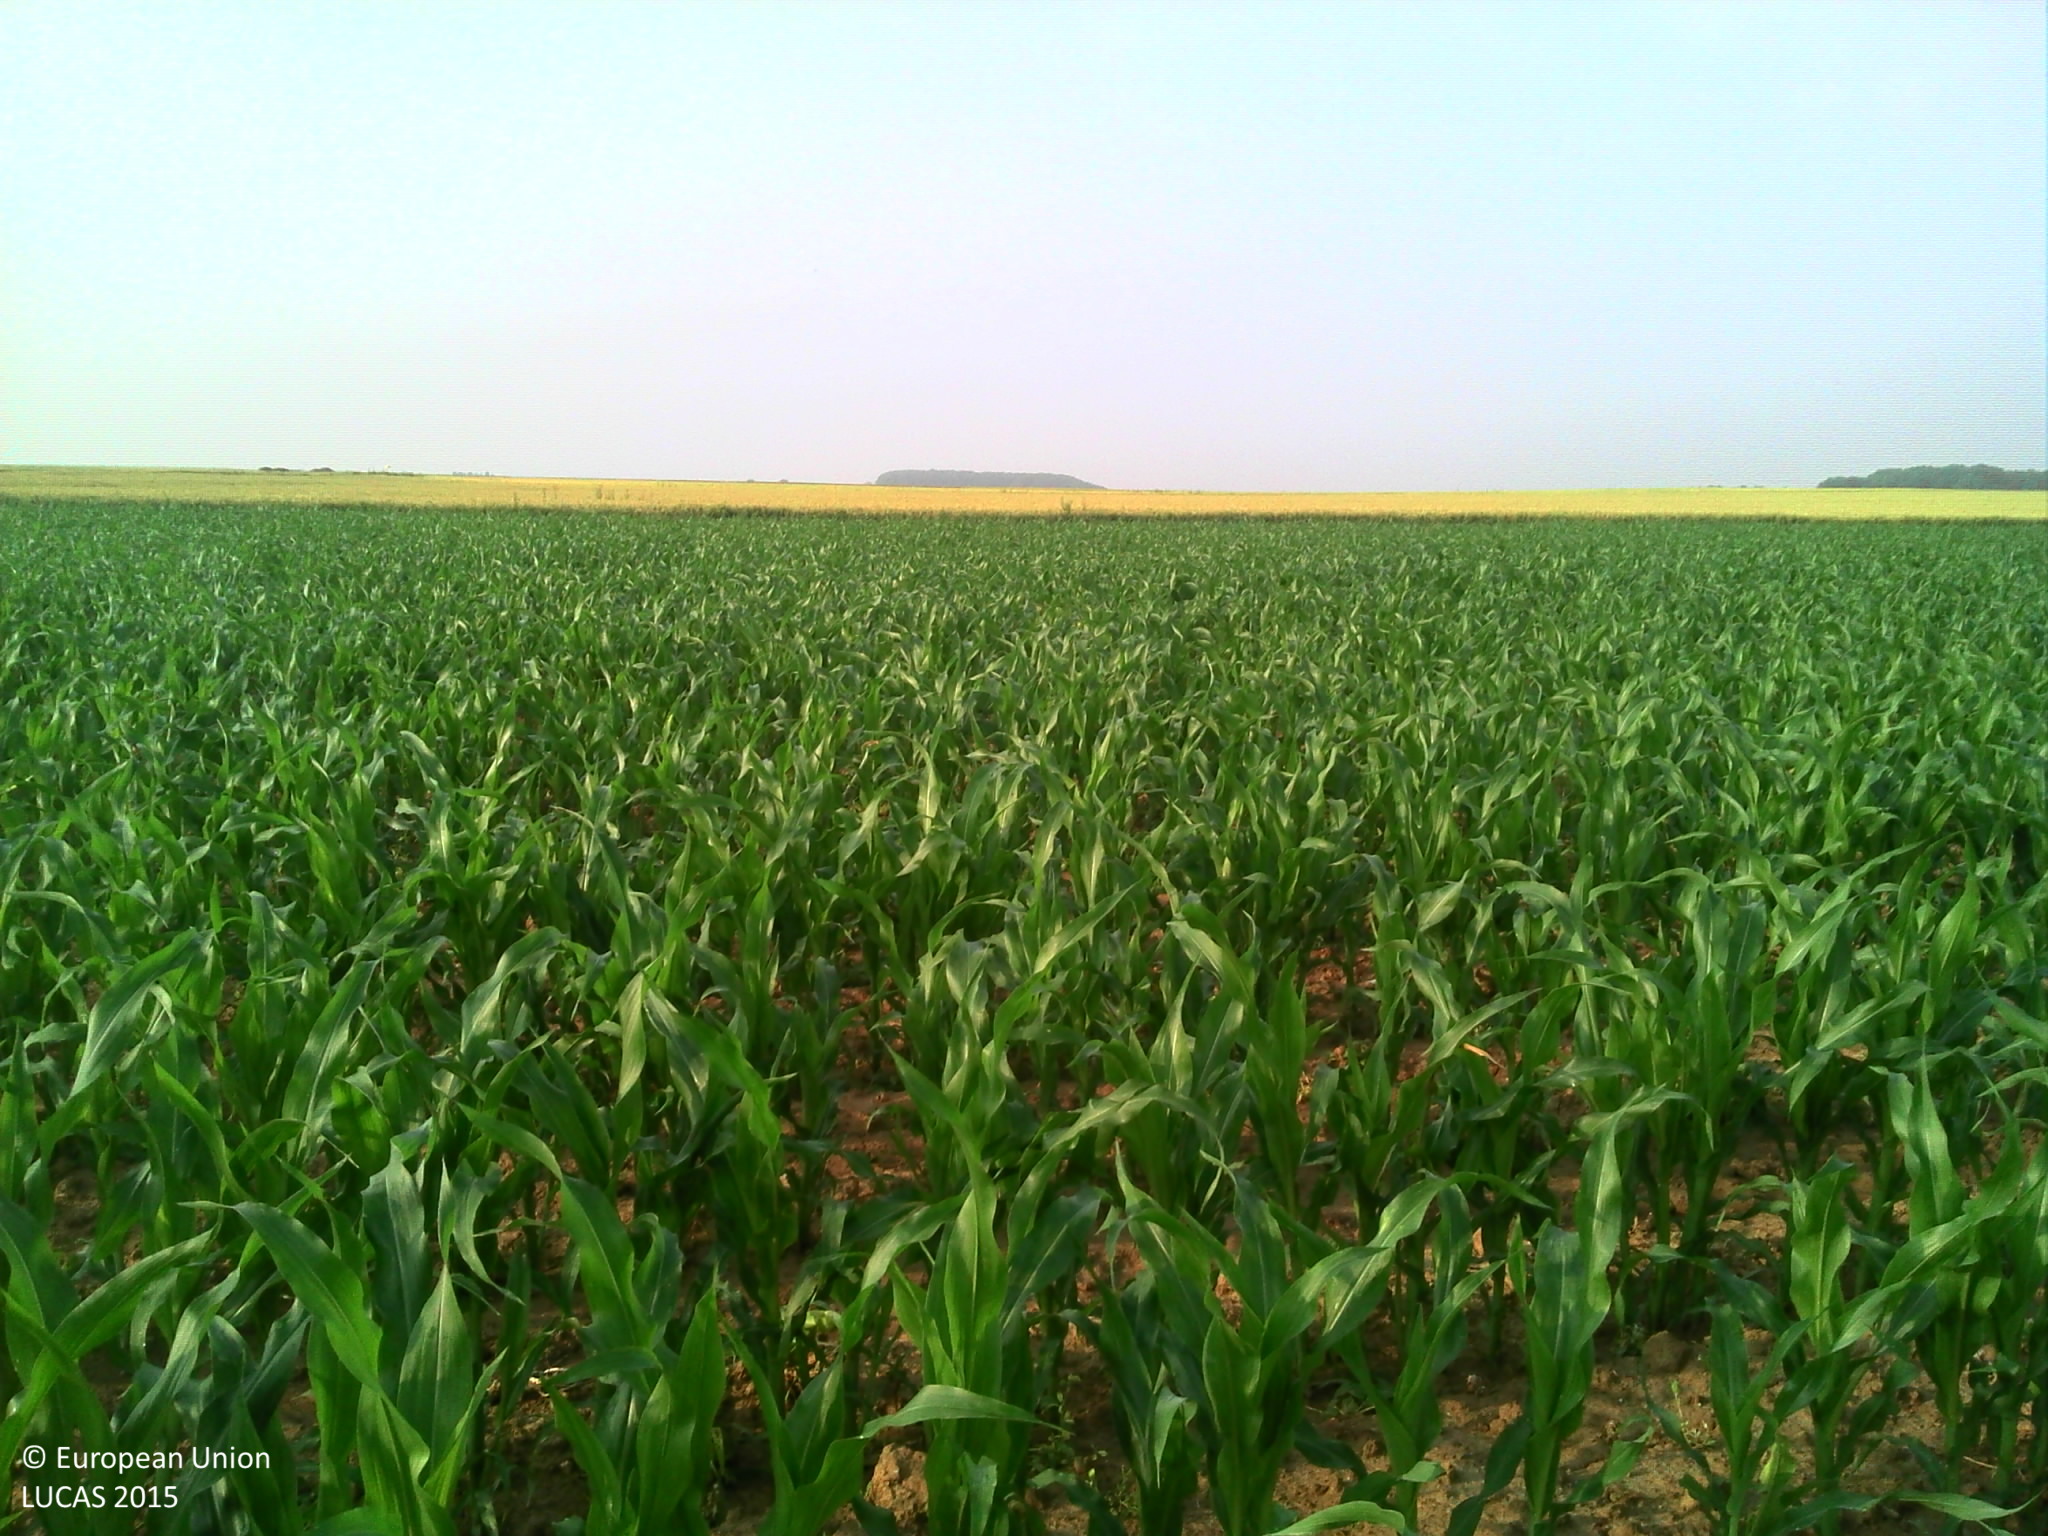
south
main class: Cropland
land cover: Maize
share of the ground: 25 - 50 %
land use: Agriculture (excluding fallow land and kitchen gardens)
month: July
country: FR
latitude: 49.7426
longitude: 2.5640
